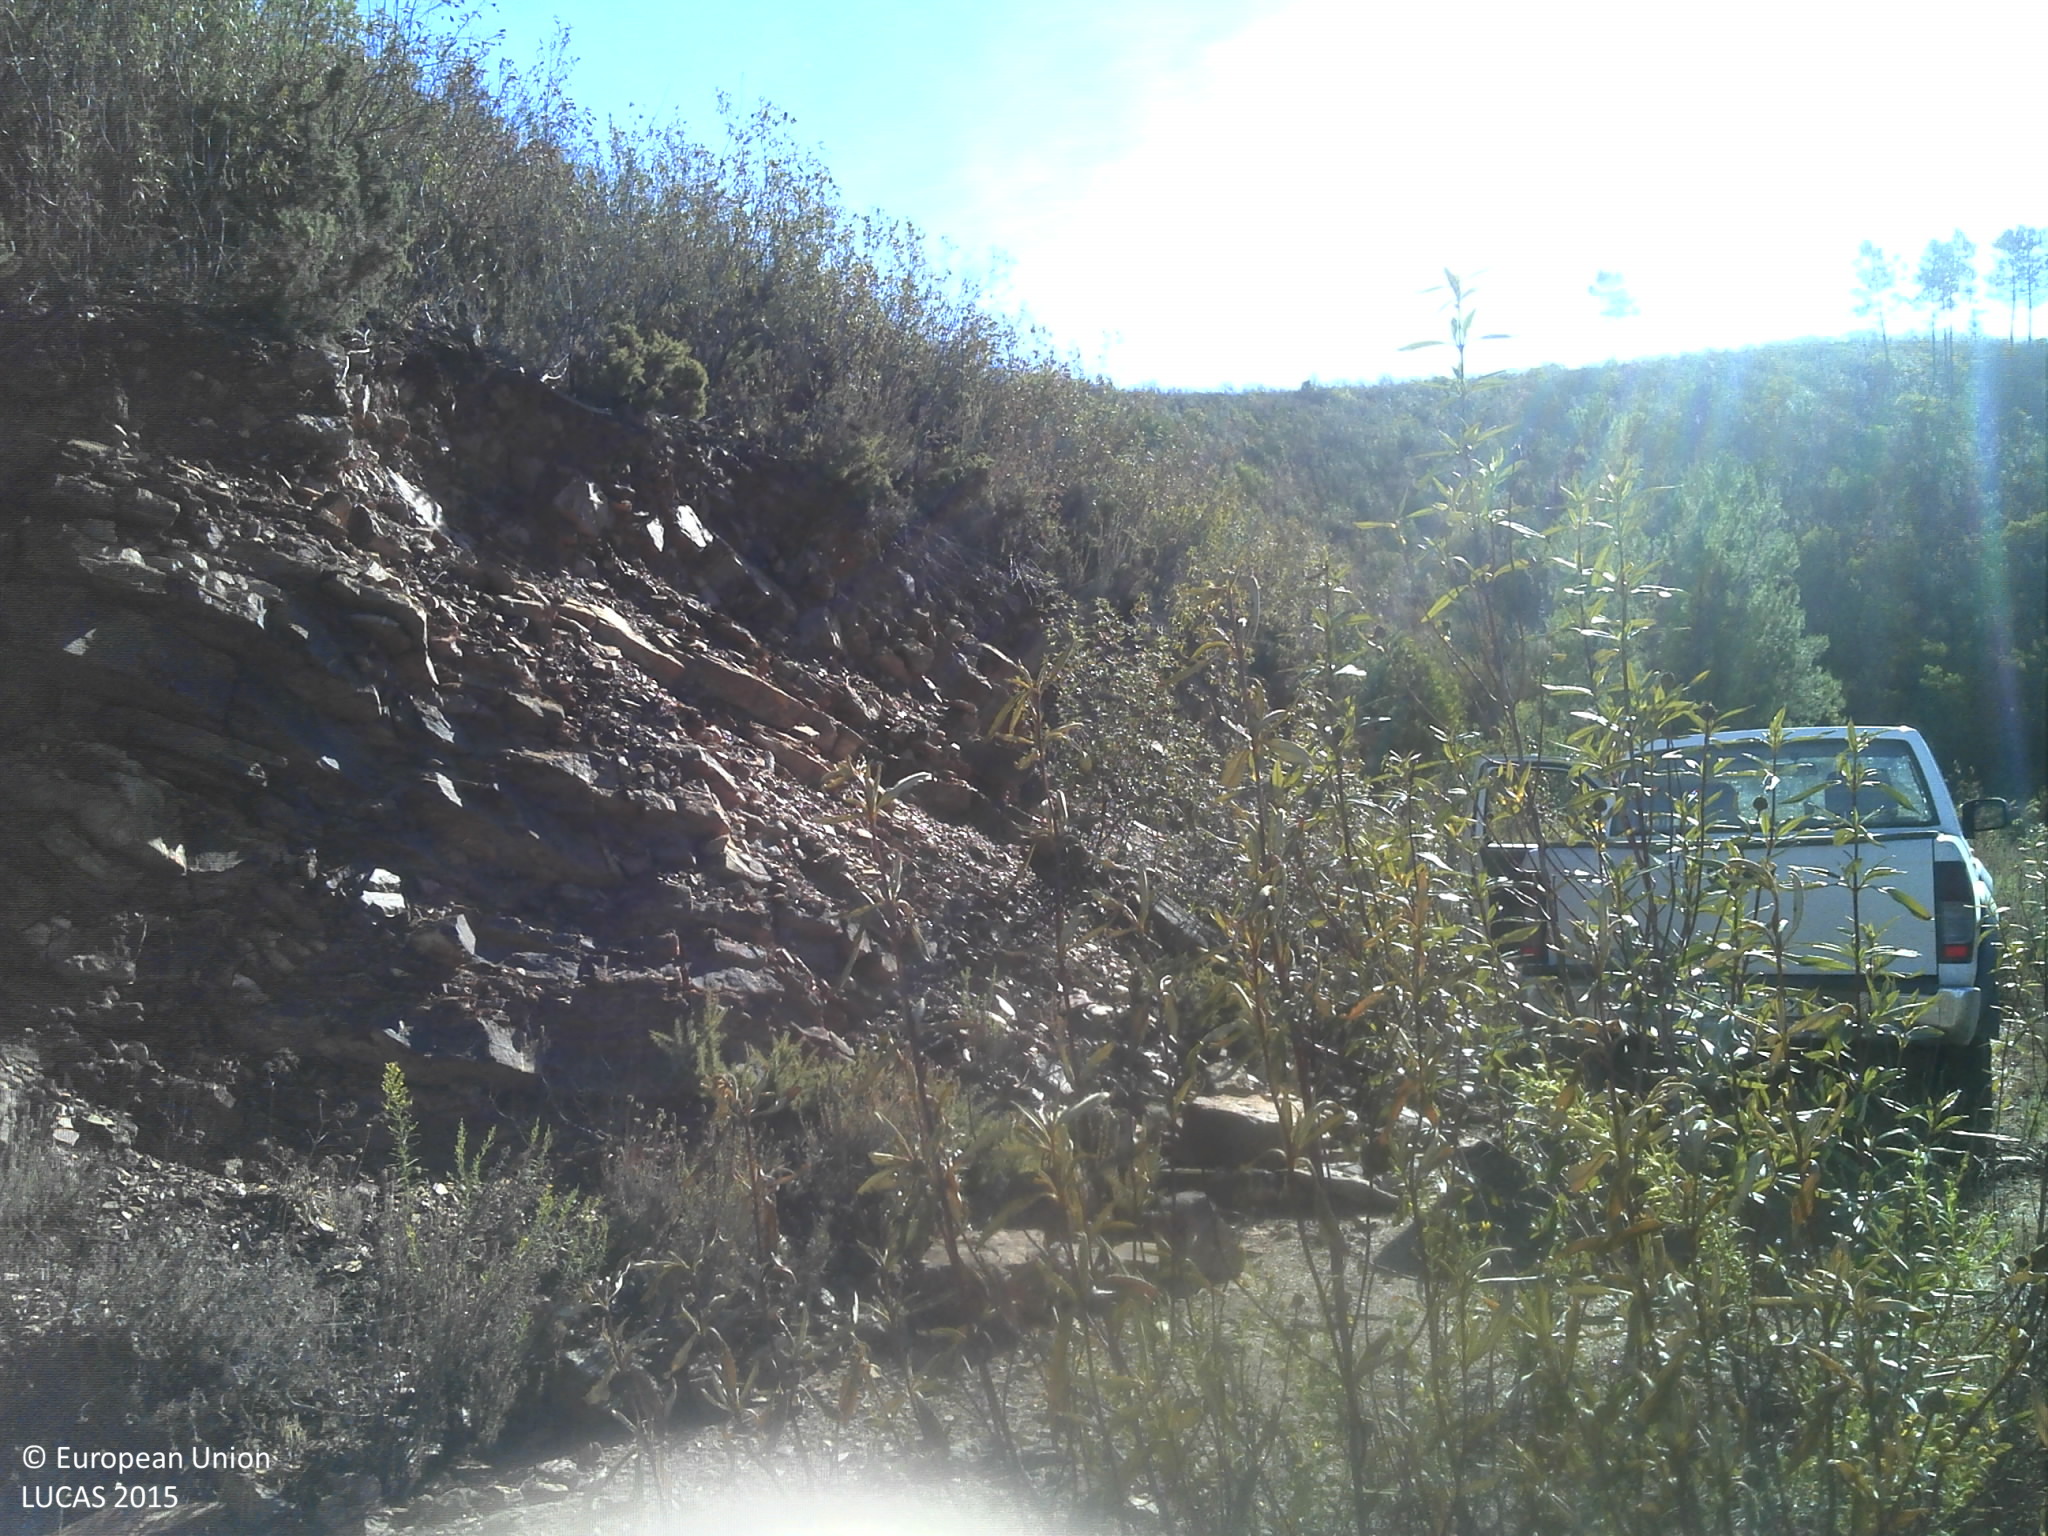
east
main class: Woodland
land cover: Pine dominated coniferous woodland
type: coniferous forest of the mediterranean region
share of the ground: 25 - 50 %
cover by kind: shrubs 55 %, coniferous forest trees 25 %, unconsolidated bare surface 20 %
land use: Forestry
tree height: > 5 m
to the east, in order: Pine dominated coniferous woodland; Shrubland without tree cover; Pine dominated coniferous woodland; Rivers and streams; Pine dominated coniferous woodland; Tracks; Pine dominated coniferous woodland; Shrubland without tree cover; Tracks; Broadleaved woodland
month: September
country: PT
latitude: 37.3014
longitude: -8.4268
